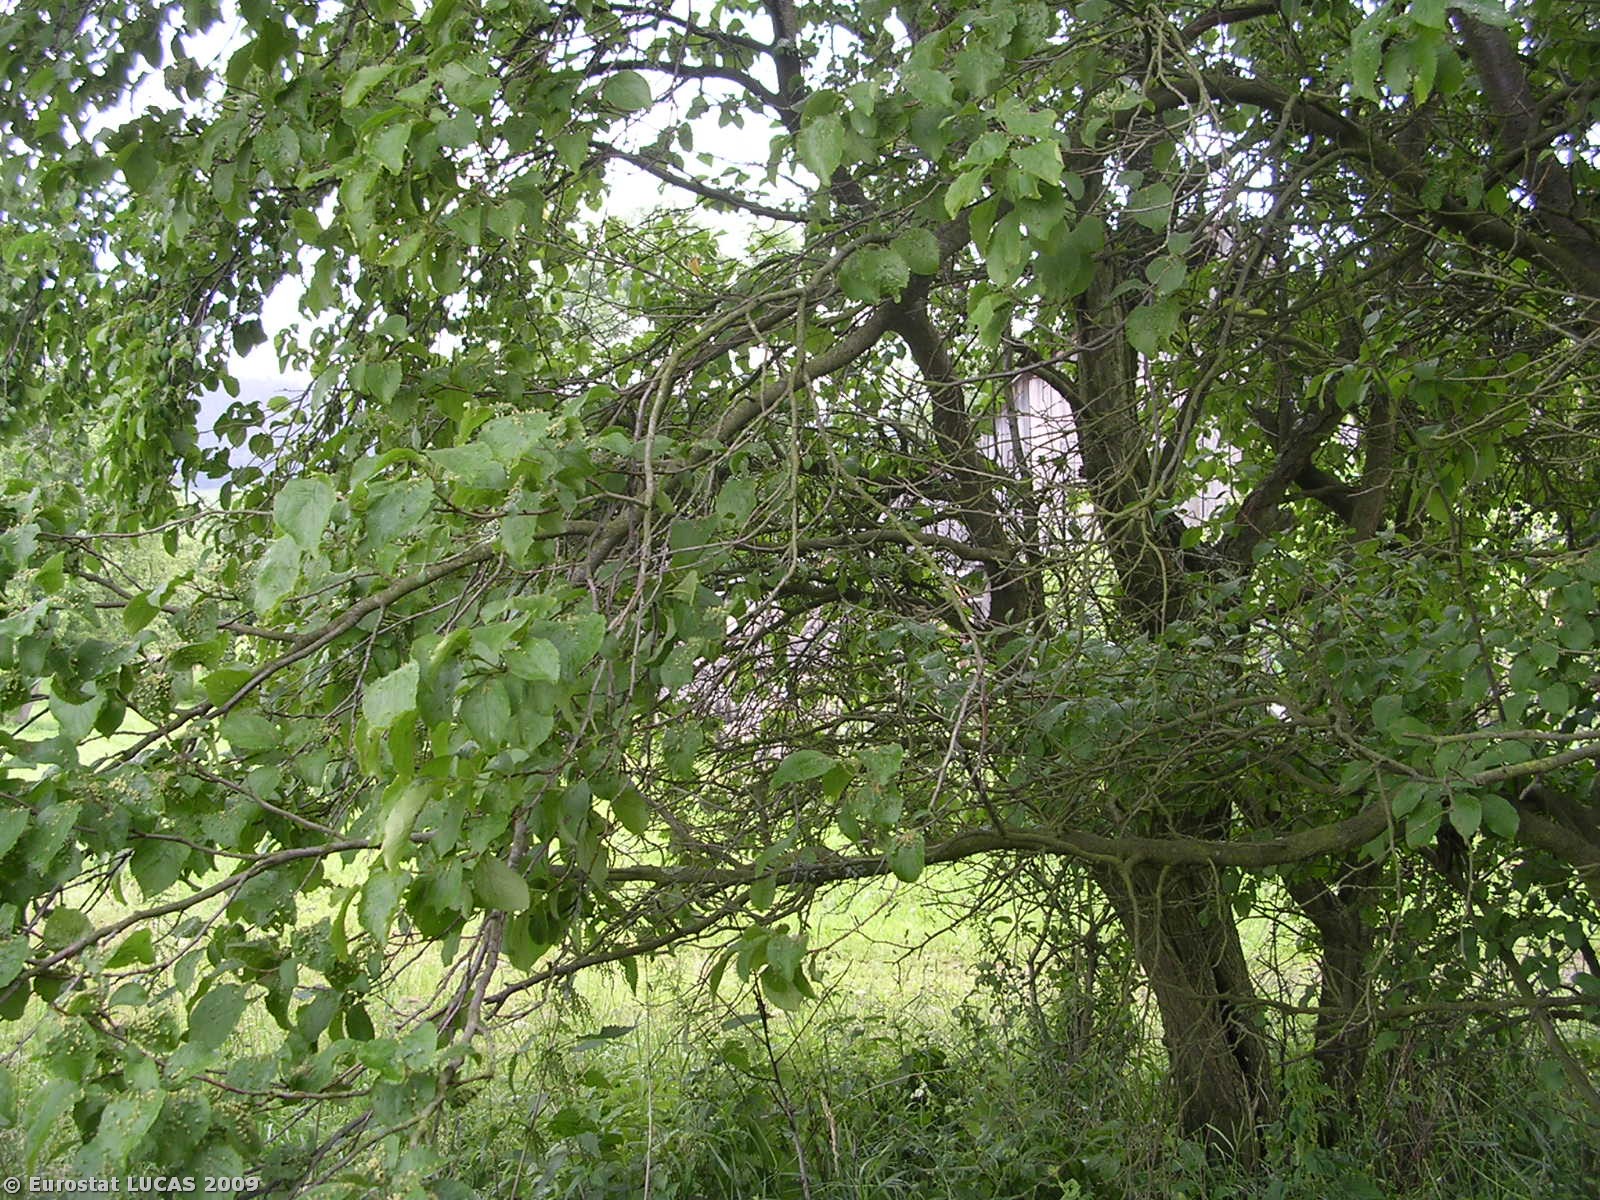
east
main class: Cropland
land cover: Other fruit trees and berries
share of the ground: 25 - 50 %
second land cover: Grassland with sparse tree/shrub cover
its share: > 75 %
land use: Kitchen garden
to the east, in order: Other fruit trees and berries; Grassland with sparse tree/shrub cover; Tracks; Artificial constructions in urban areas; Fences; Apple fruit; Grassland with sparse tree/shrub cover; Grassland without tree/shrub cover; Electric lines; Grassland with sparse tree/shrub cover; Paved roads, cycling and walking lanes; Grassland with sparse tree/shrub cover; Electric lines; Grassland without tree/shrub cover; Broadleaved woodland; Inland running water; Broadleaved woodland
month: July
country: CZ
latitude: 50.6488
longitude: 15.0520
